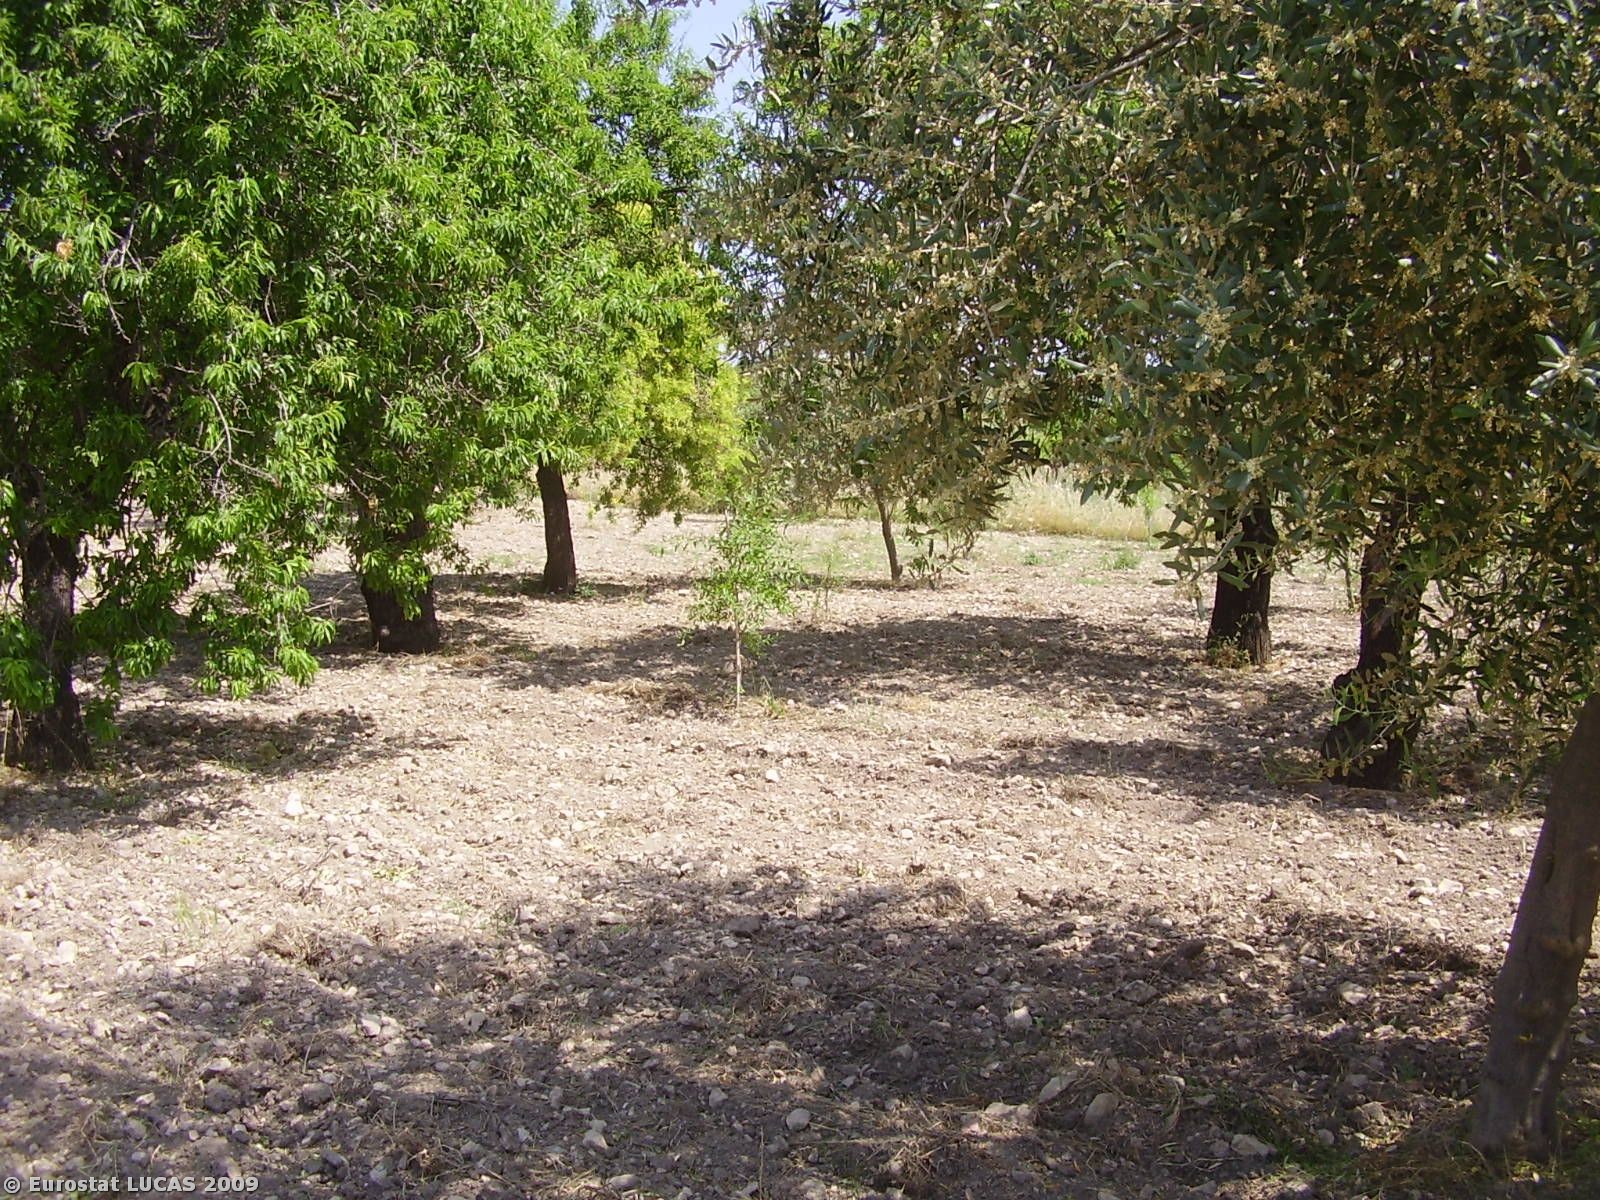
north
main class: Cropland
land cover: Nuts trees
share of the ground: 25 - 50 %
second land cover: Bare land
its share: > 75 %
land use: Agriculture (excluding fallow land and kitchen gardens)
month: May
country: IT
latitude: 36.8907
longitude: 14.9542
